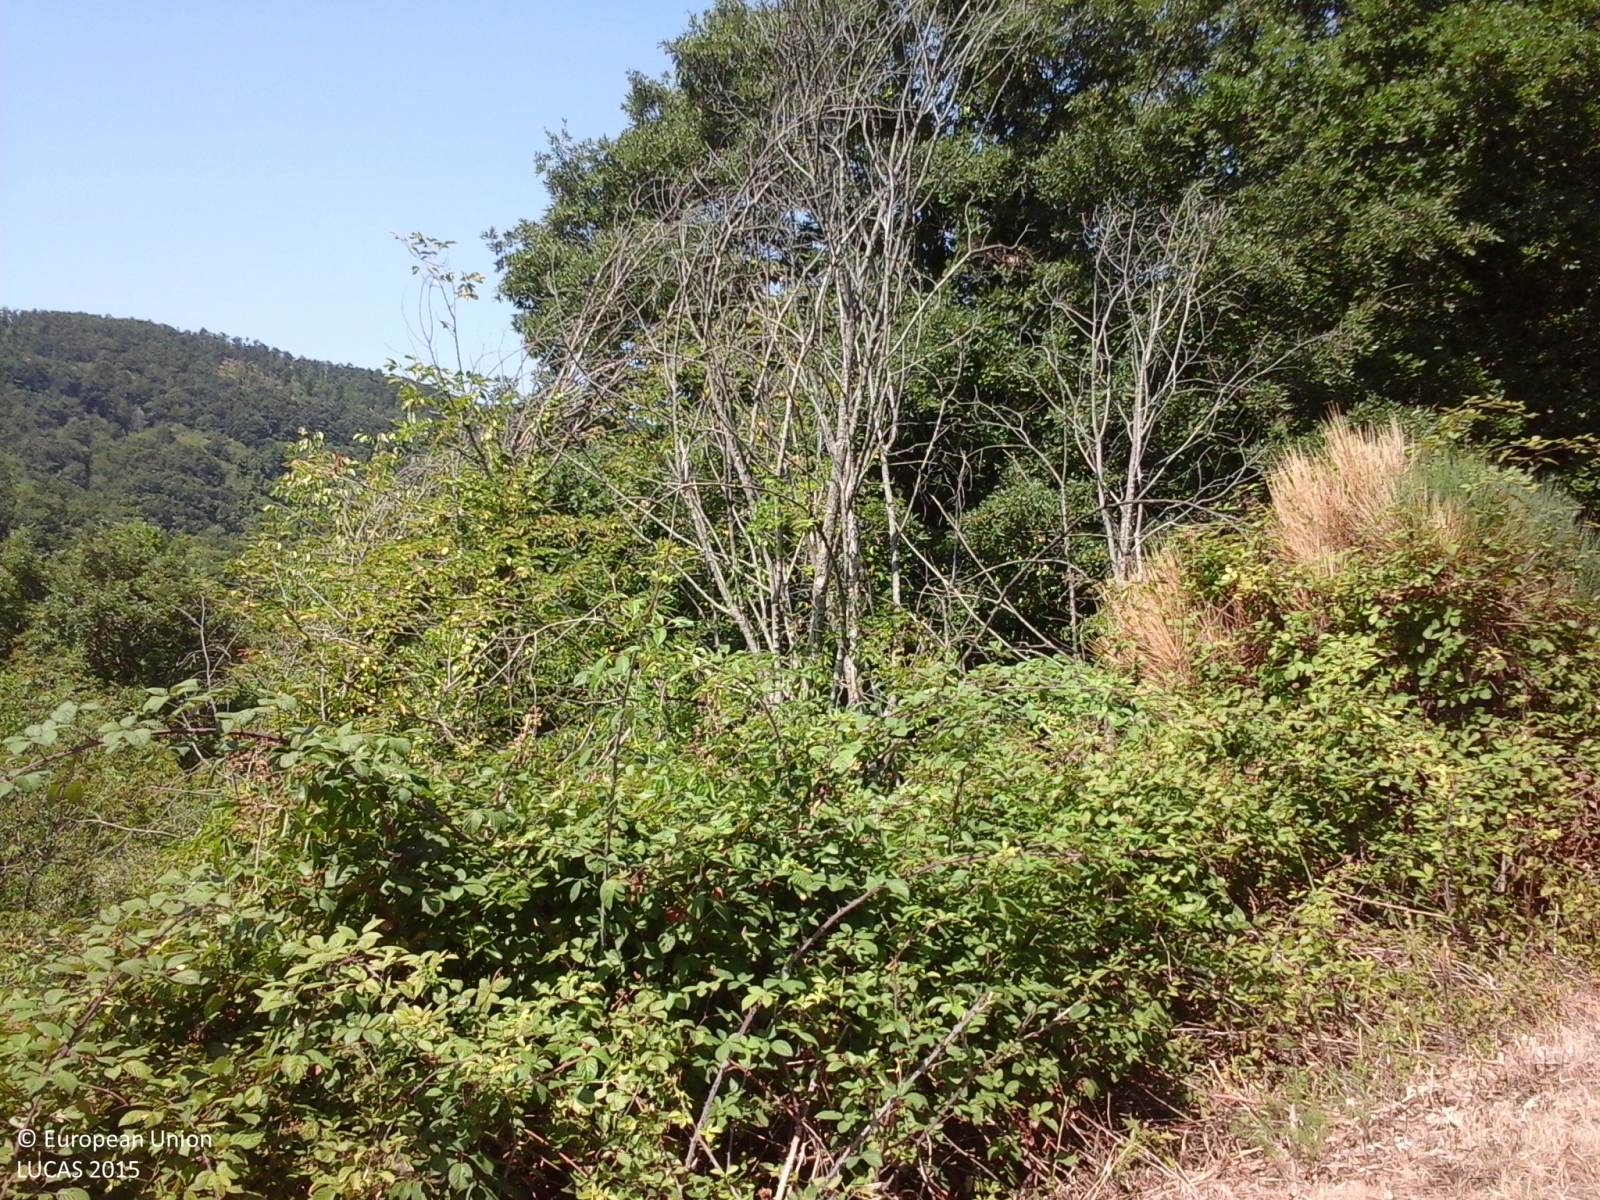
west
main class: Woodland
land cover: Broadleaved woodland
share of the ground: > 75 %
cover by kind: broadleaved forest trees 100 %
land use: Residential
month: July
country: IT
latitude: 43.4646
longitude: 10.6286
